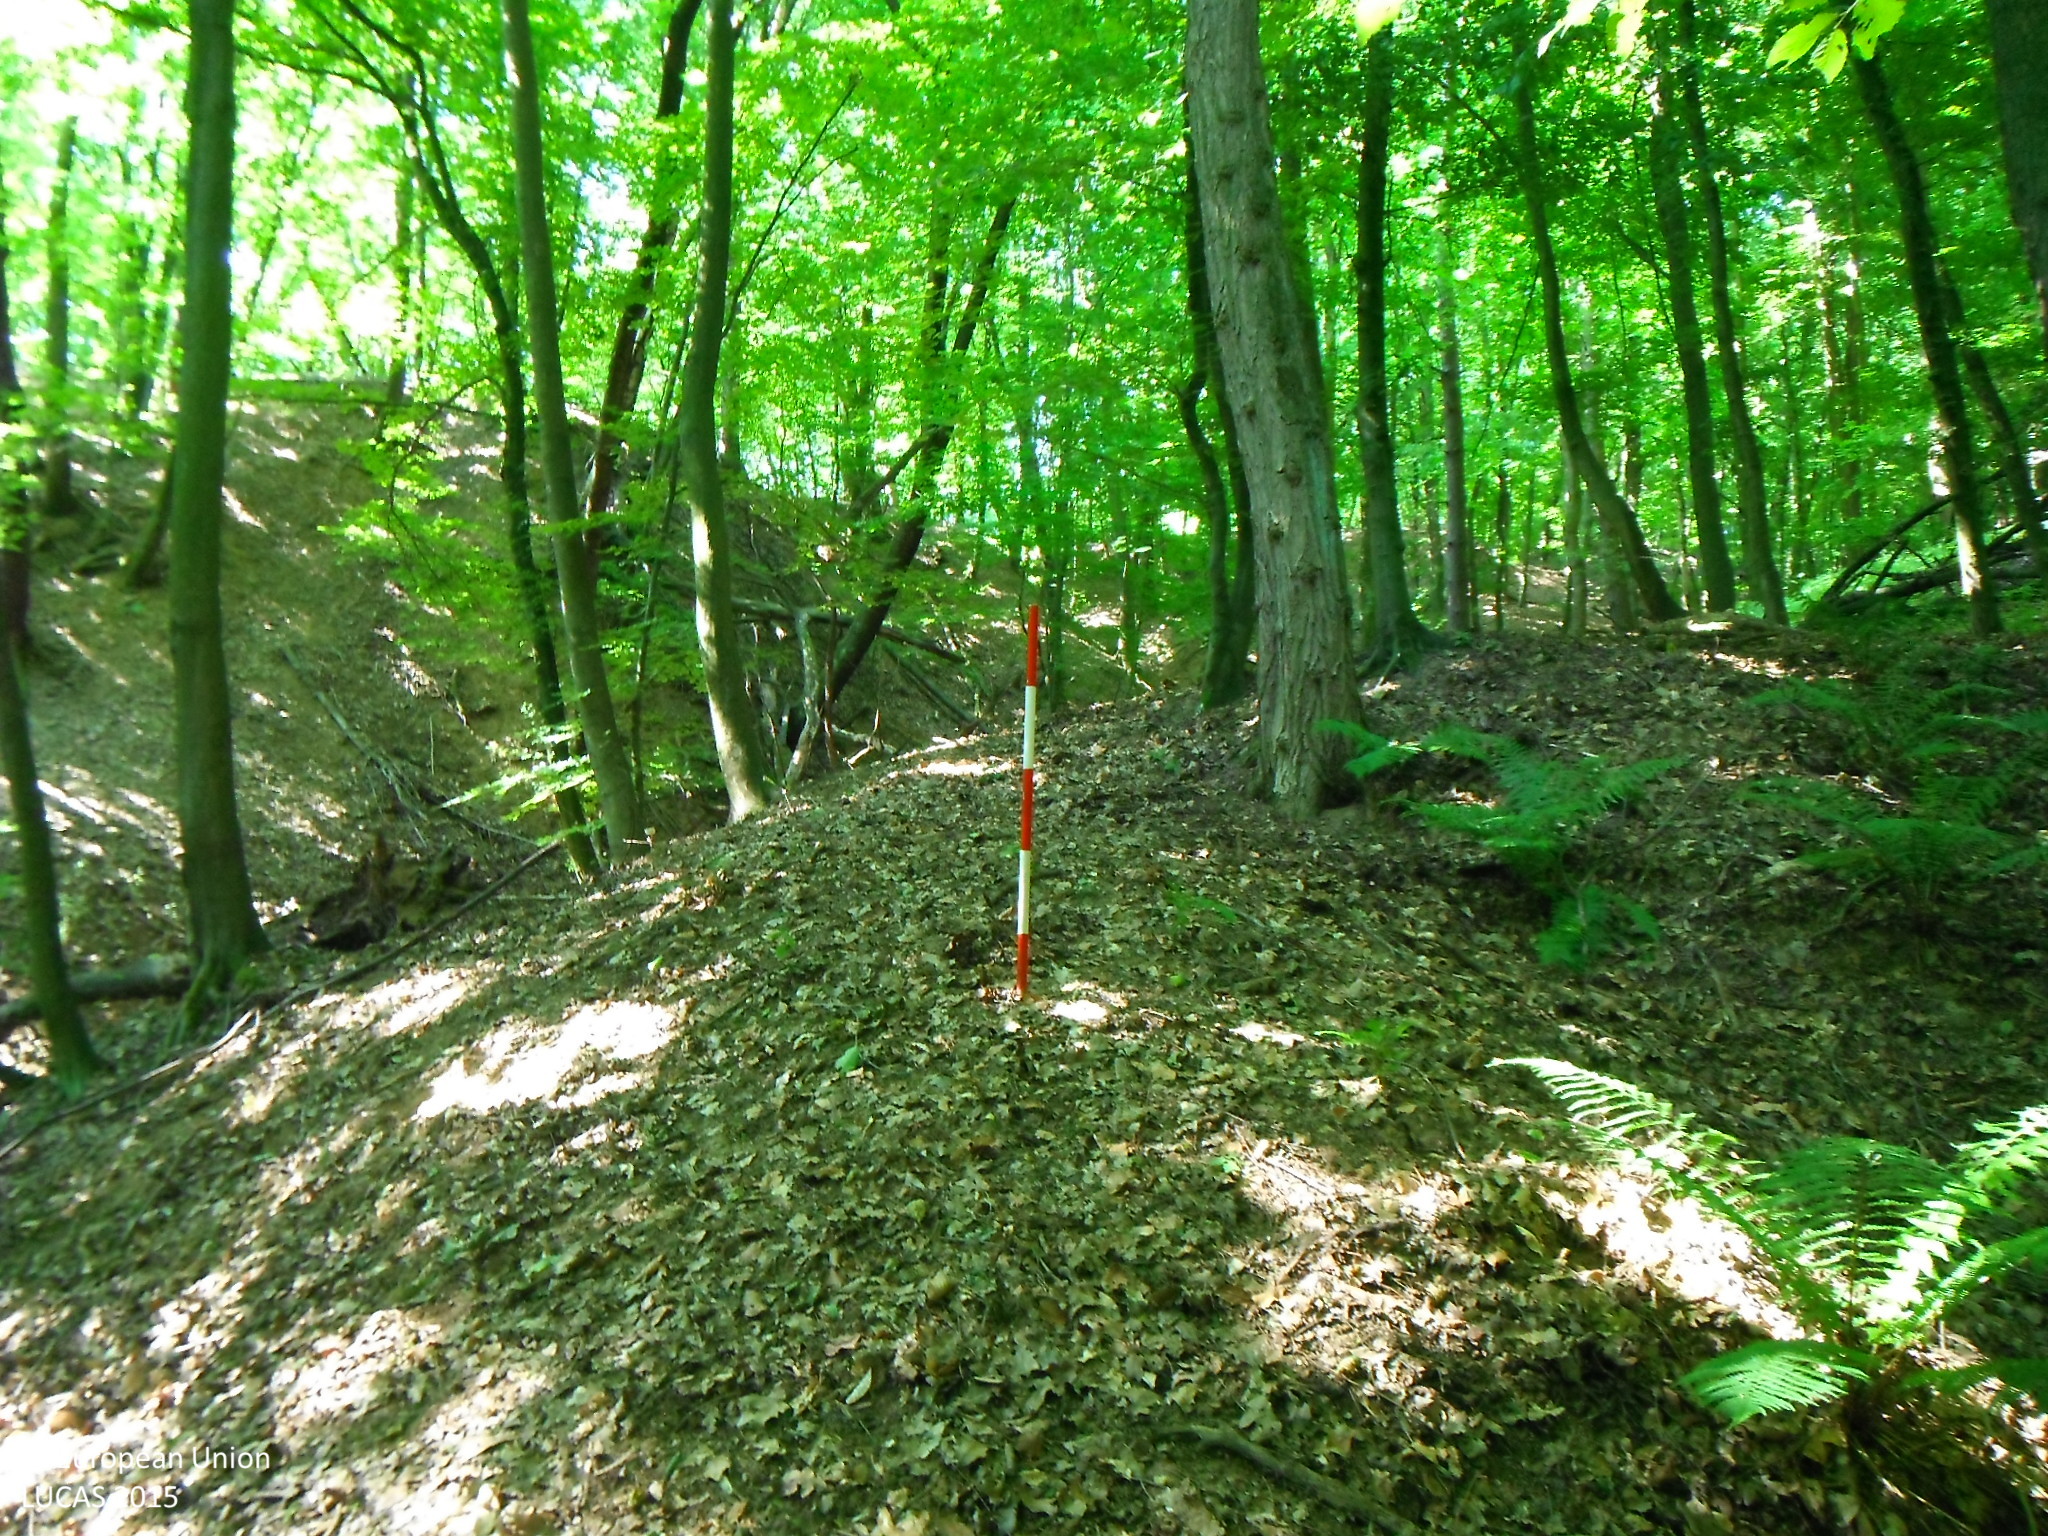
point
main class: Woodland
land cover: Broadleaved woodland
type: beech forest
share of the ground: > 75 %
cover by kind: broadleaved forest trees 95 %, coniferous forest trees 5 %
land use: Forestry
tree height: > 5 m
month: July
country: SK
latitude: 48.9293
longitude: 21.8324
